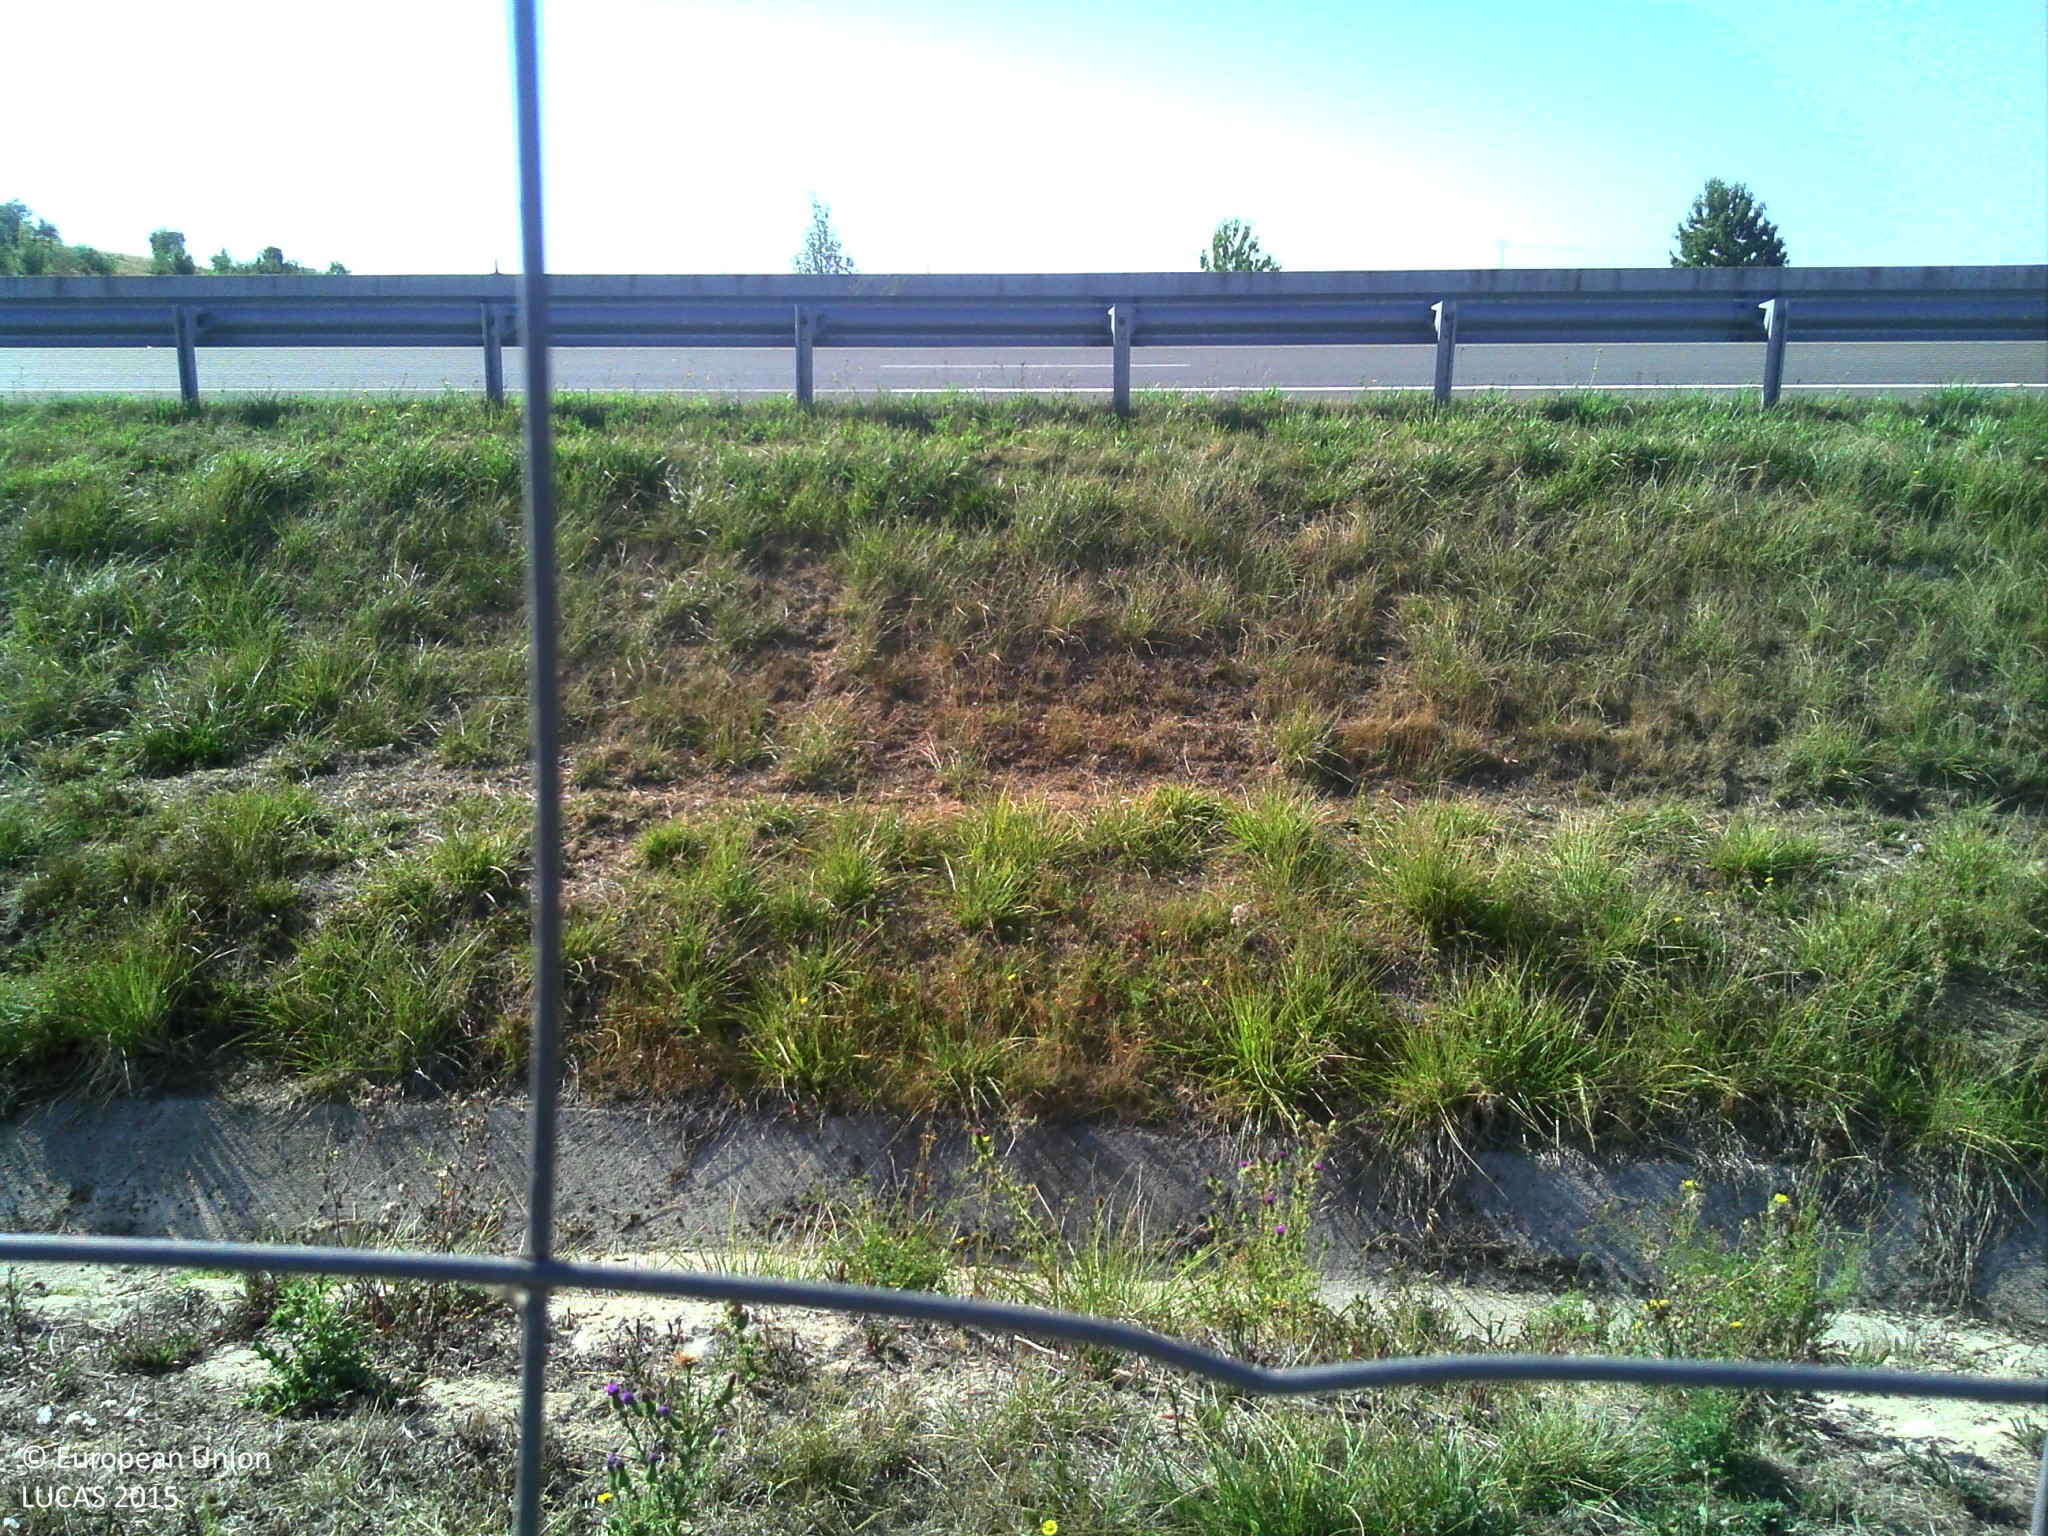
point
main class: Grassland
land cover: Grassland without tree/shrub cover
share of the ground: > 75 %
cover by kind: herbaceous plants 100 %
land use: Road transport
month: August
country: FR
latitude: 48.0971
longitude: 2.0250
